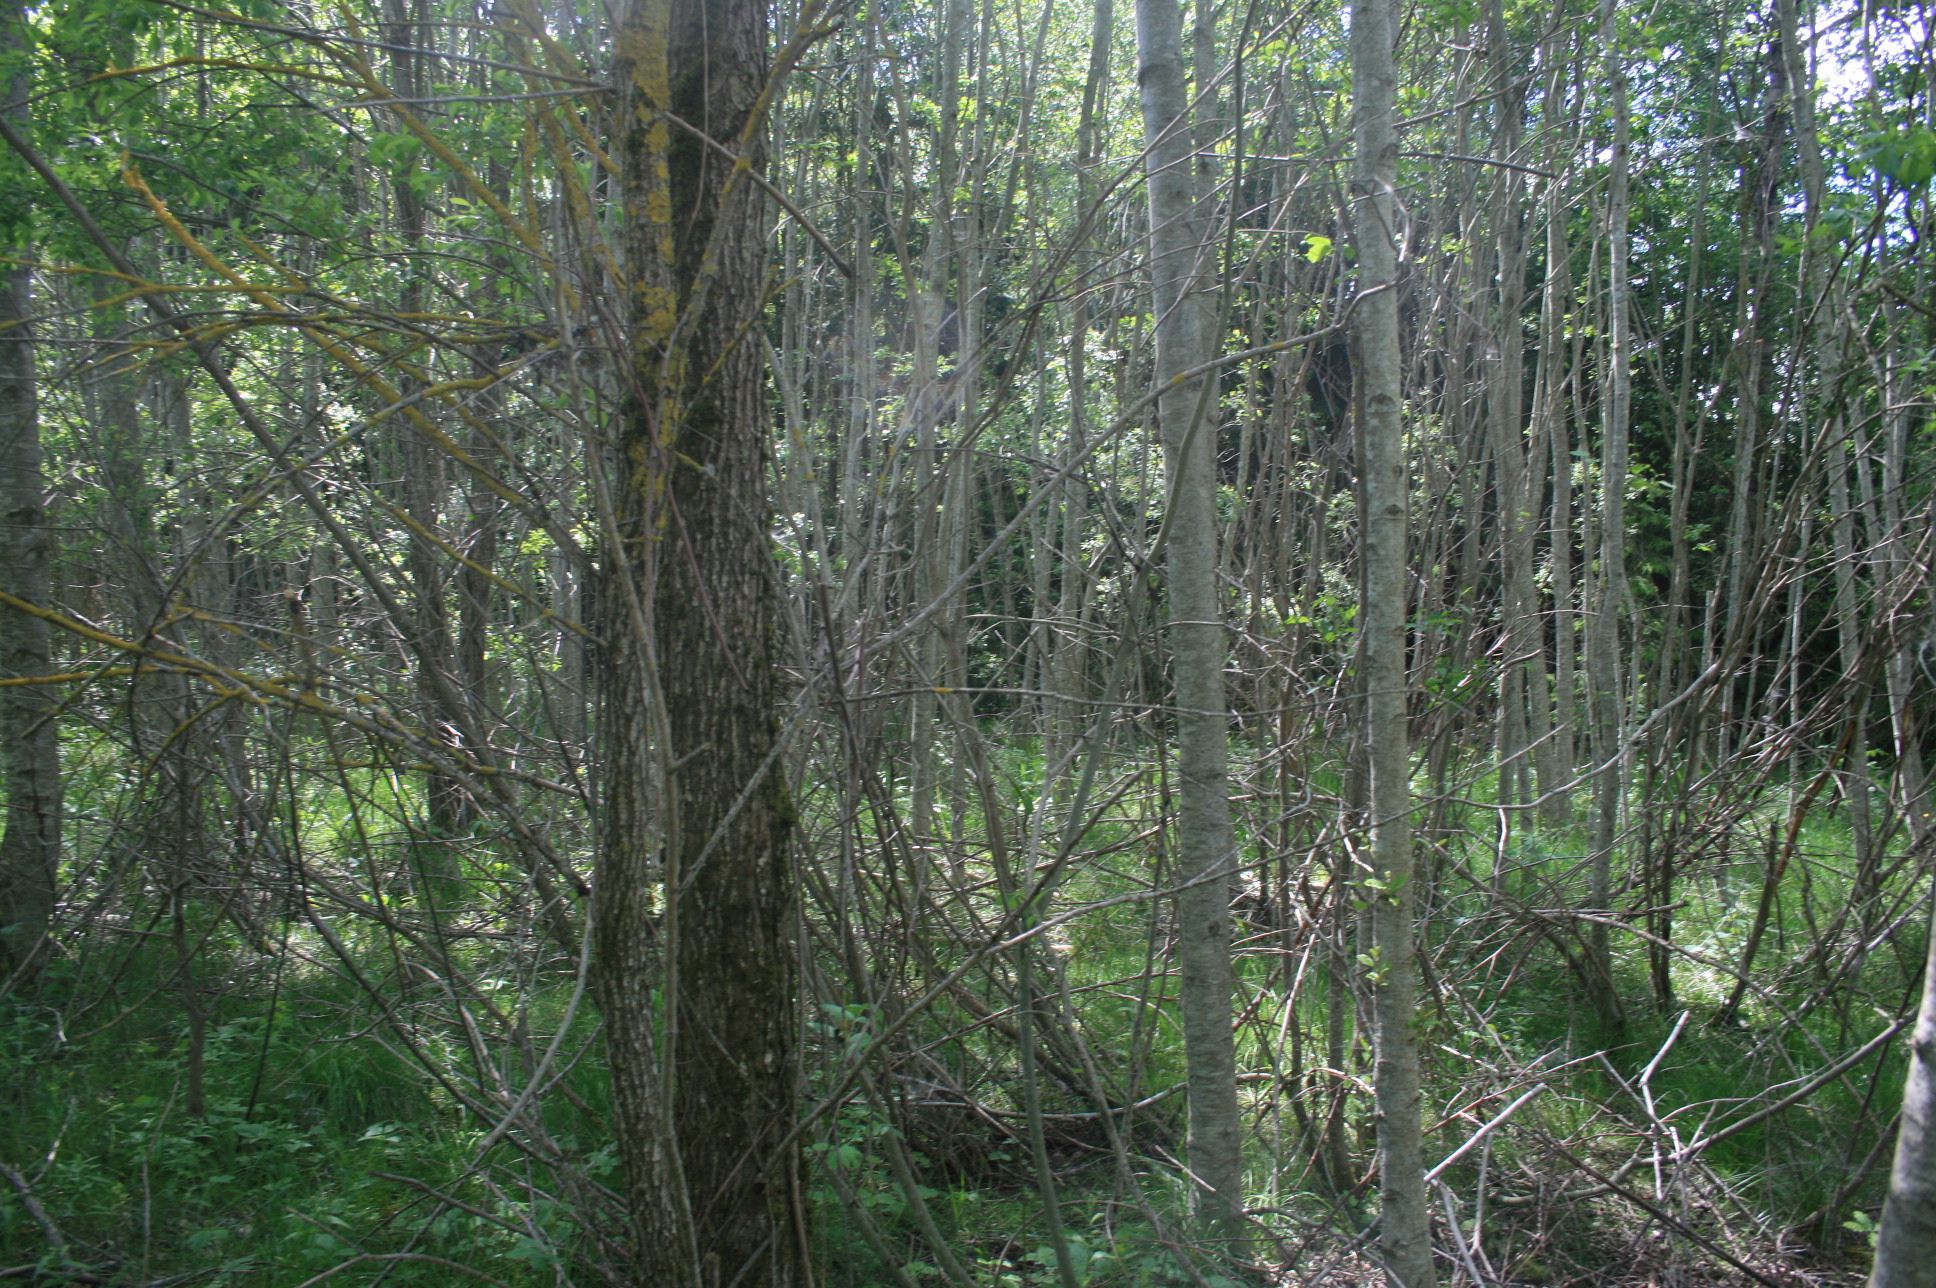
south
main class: Woodland
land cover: Broadleaved woodland
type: non-riverine alder, birch or aspen forest
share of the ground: > 75 %
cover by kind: broadleaved forest trees 95 %, herbaceous plants 5 %
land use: Forestry
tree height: > 5 m
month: June
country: LT
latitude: 56.1509
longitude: 22.3712
